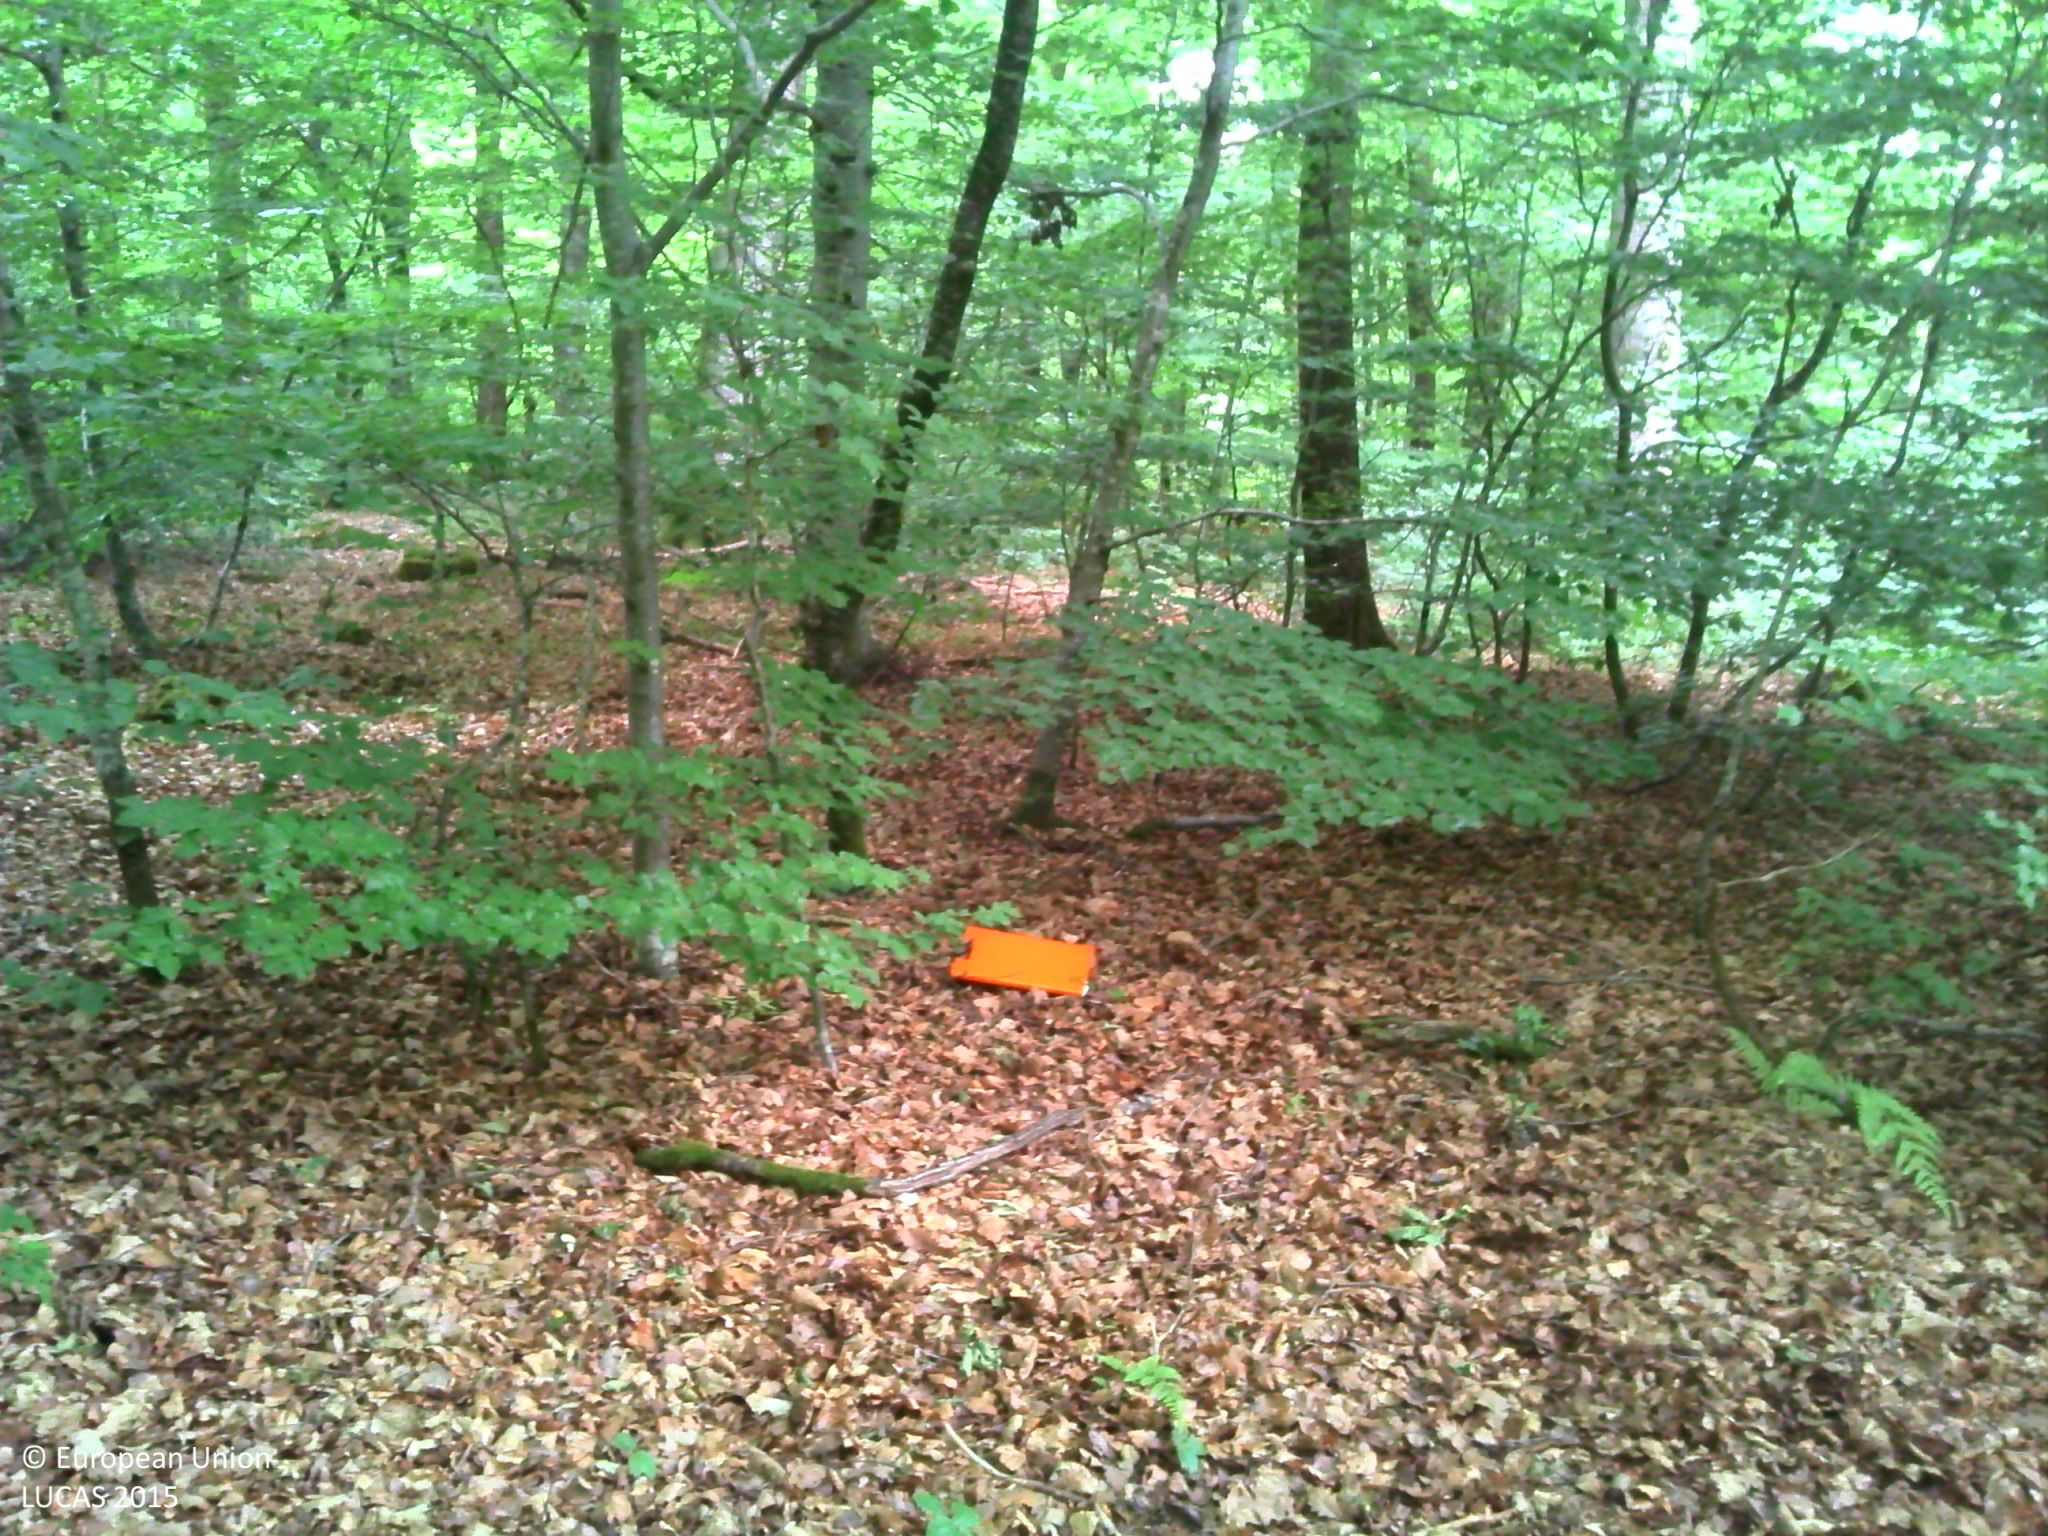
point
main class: Woodland
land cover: Broadleaved woodland
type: beech forest
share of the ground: > 75 %
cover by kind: broadleaved forest trees 85 %, unconsolidated bare surface 10 %, herbaceous plants 5 %
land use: Forestry
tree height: > 5 m
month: June
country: FR
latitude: 47.5326
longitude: 6.3486
